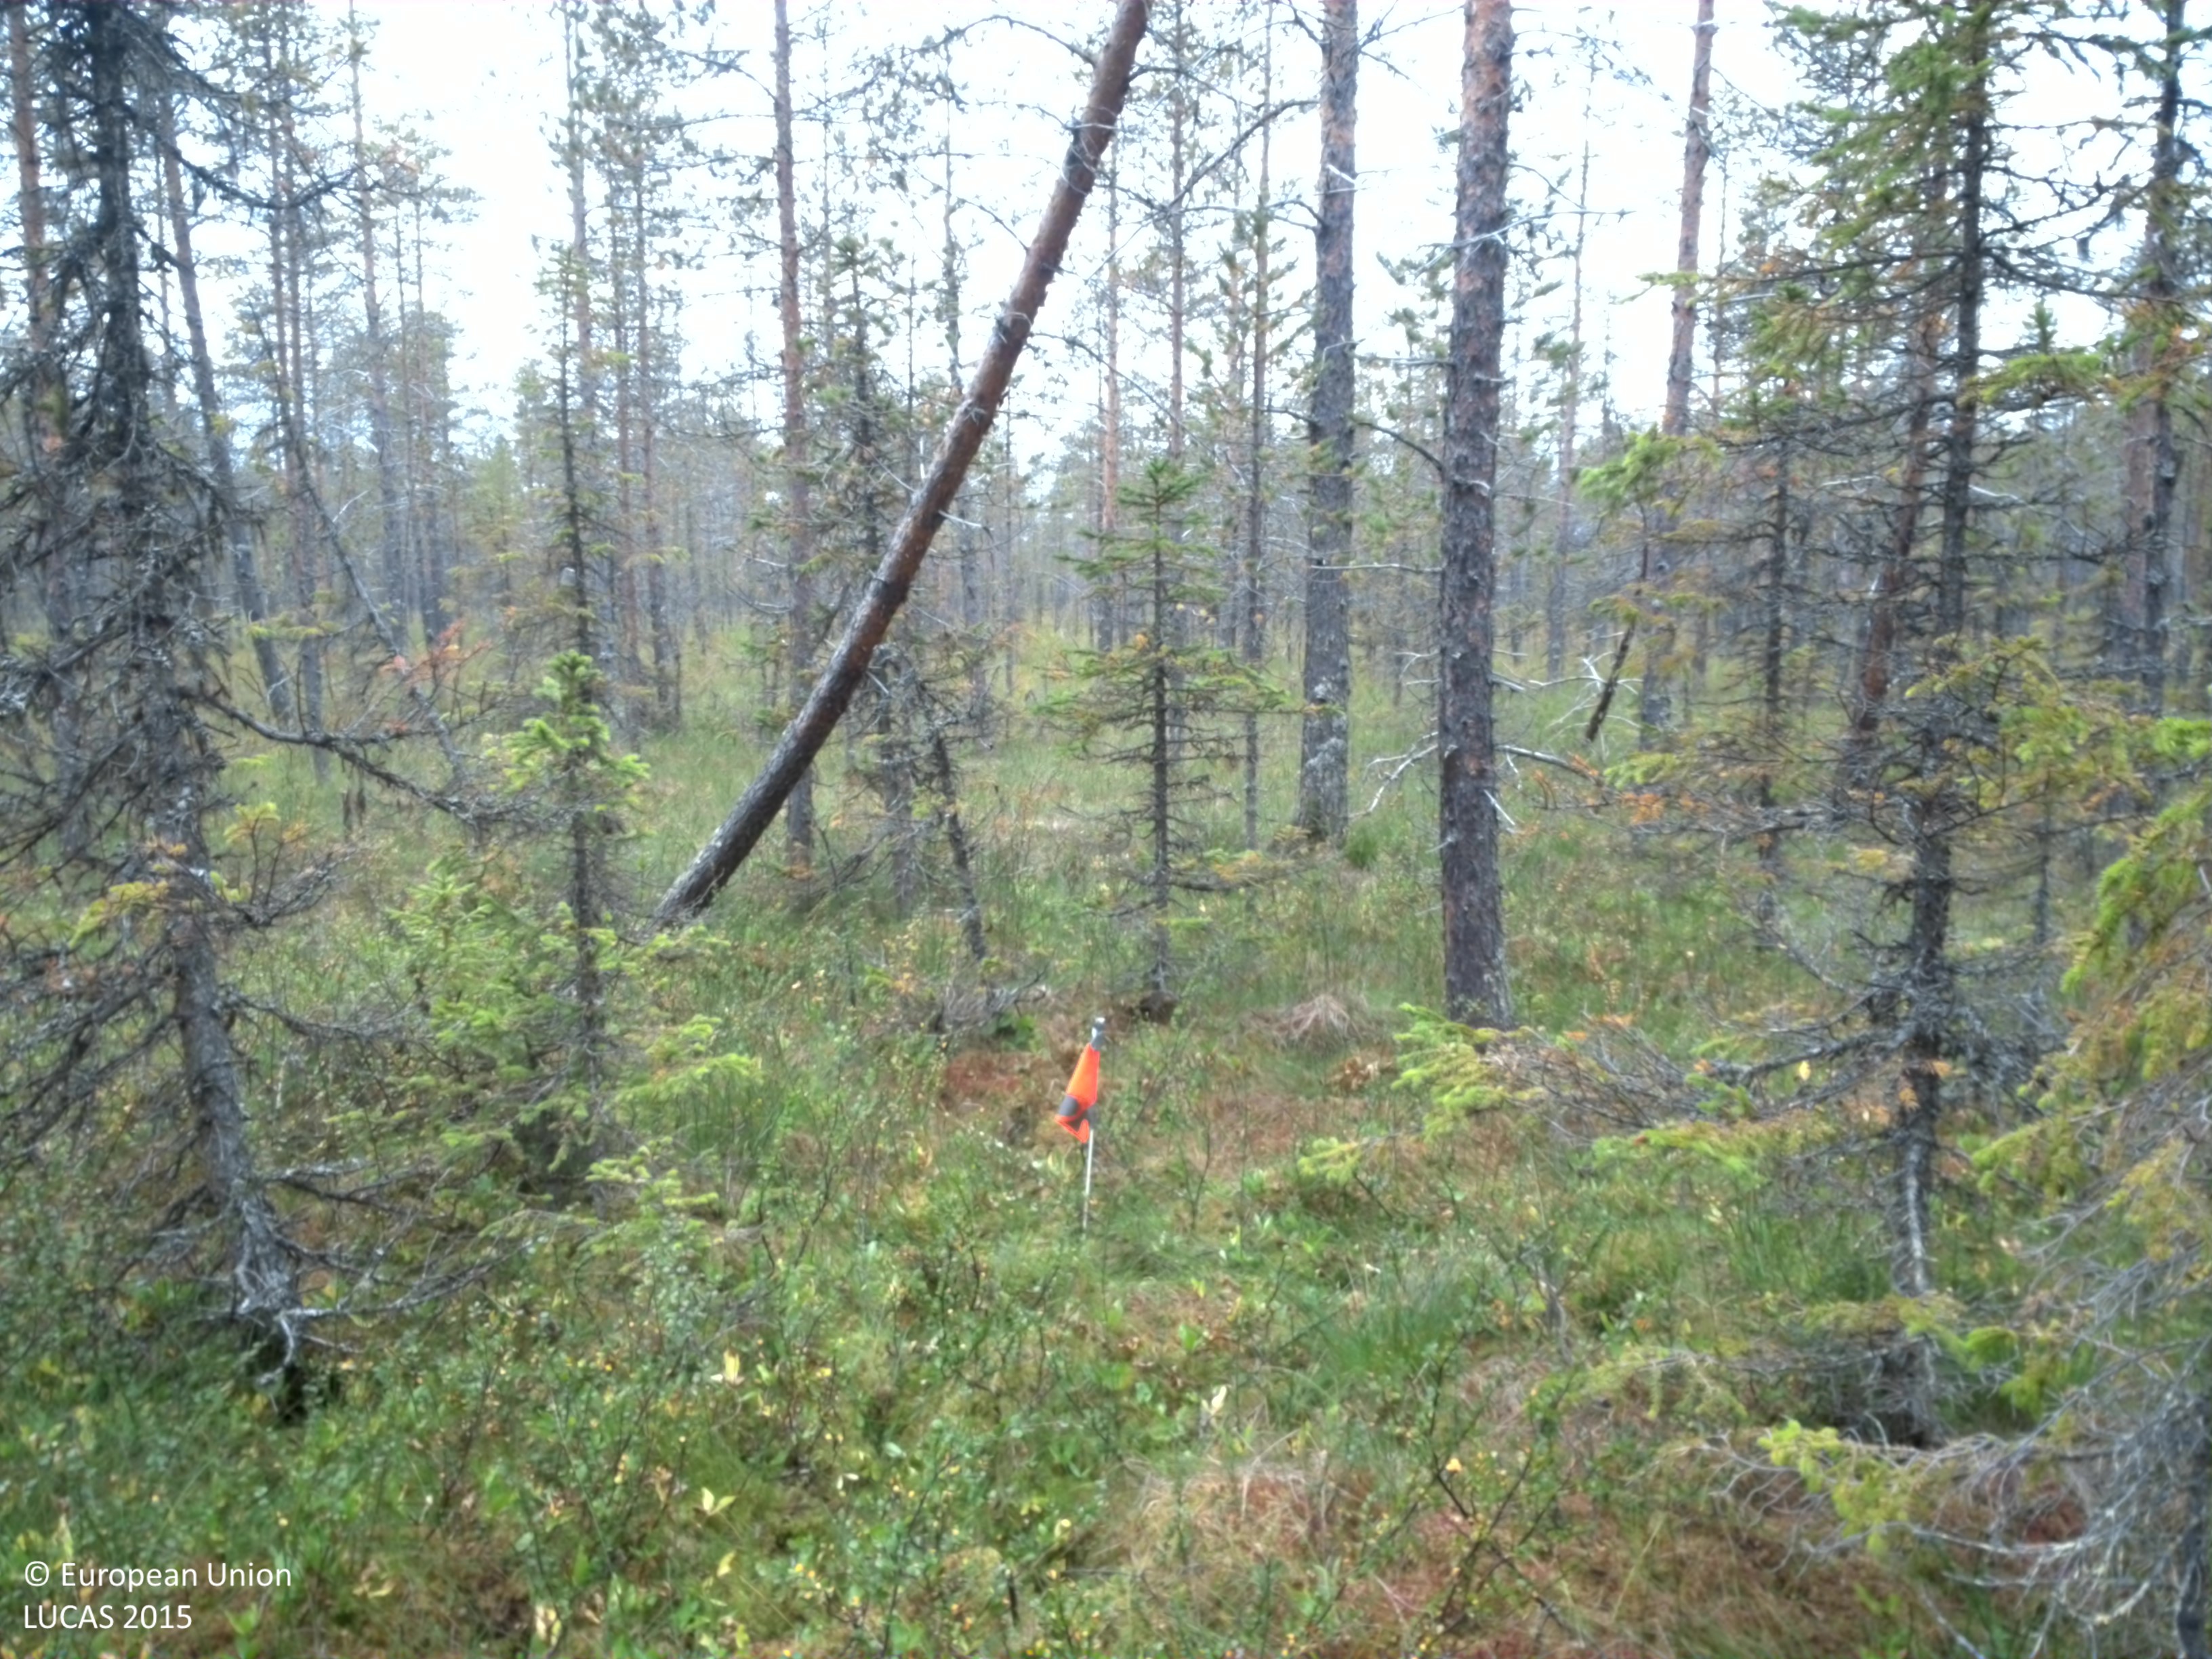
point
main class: Woodland
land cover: Pine dominated coniferous woodland
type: mire and swamp forests
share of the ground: 10 - 25 %
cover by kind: lichens and mosses 35 %, herbaceous plants 30 %, coniferous forest trees 20 %, shrubs 15 %
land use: Semi-natural and natural areas not in use
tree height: > 5 m
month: August
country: SE
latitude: 64.7476
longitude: 16.6678
